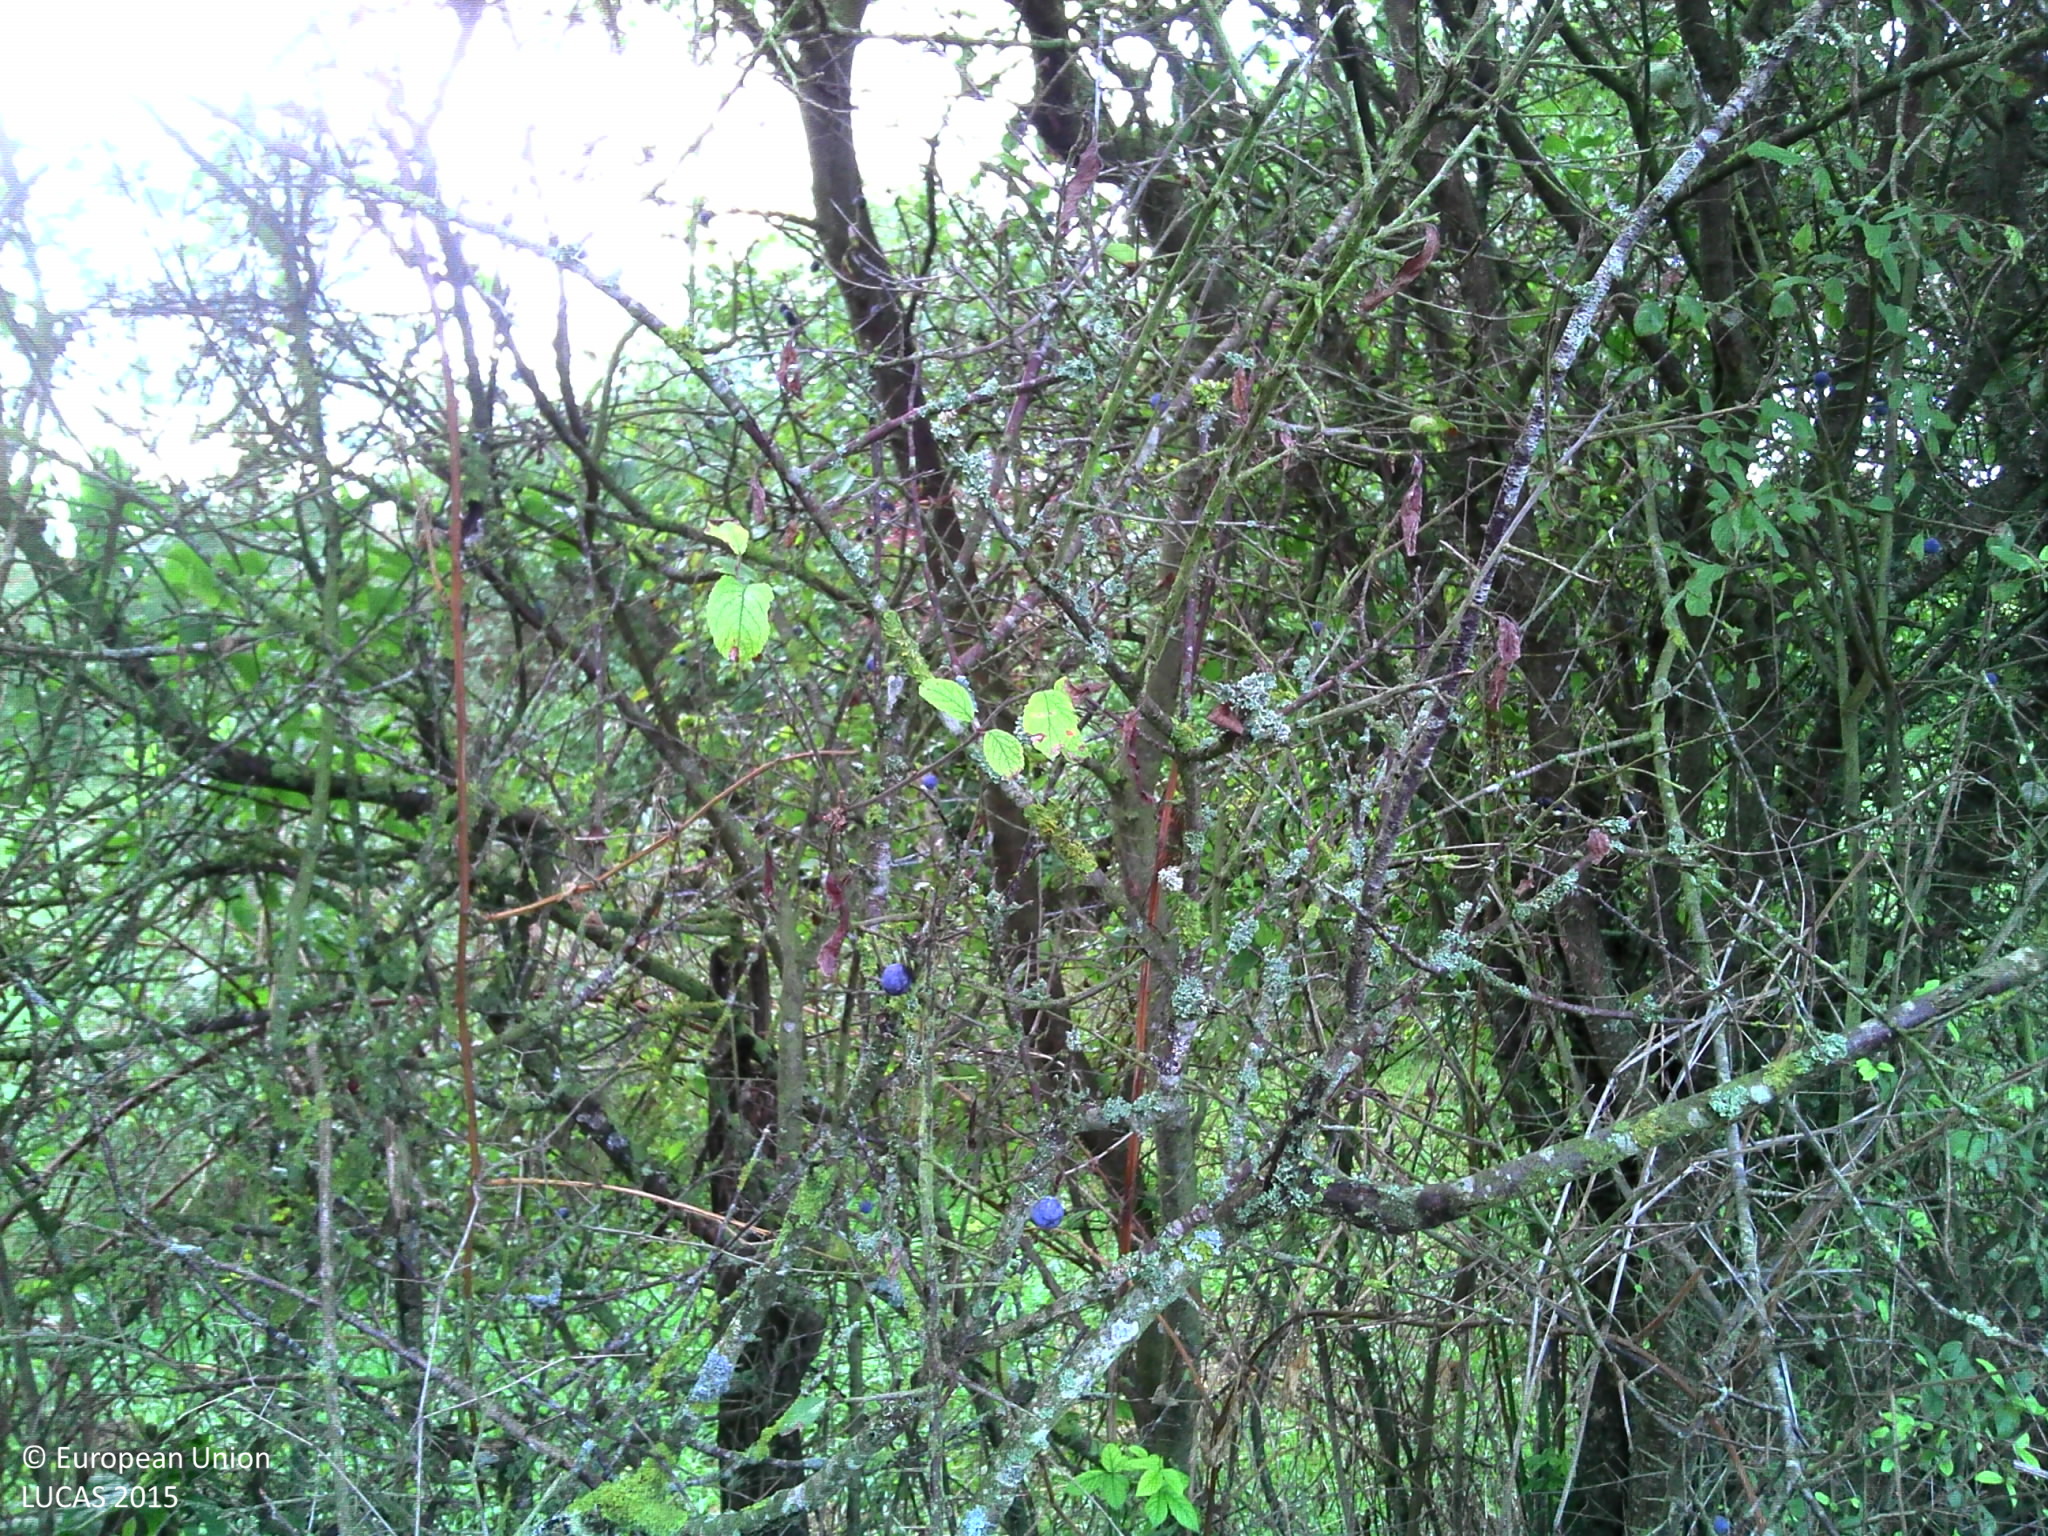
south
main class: Grassland
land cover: Grassland without tree/shrub cover
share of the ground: > 75 %
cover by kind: herbaceous plants 100 %
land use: Agriculture (excluding fallow land and kitchen gardens)
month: September
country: FR
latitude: 47.0814
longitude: 4.9827
